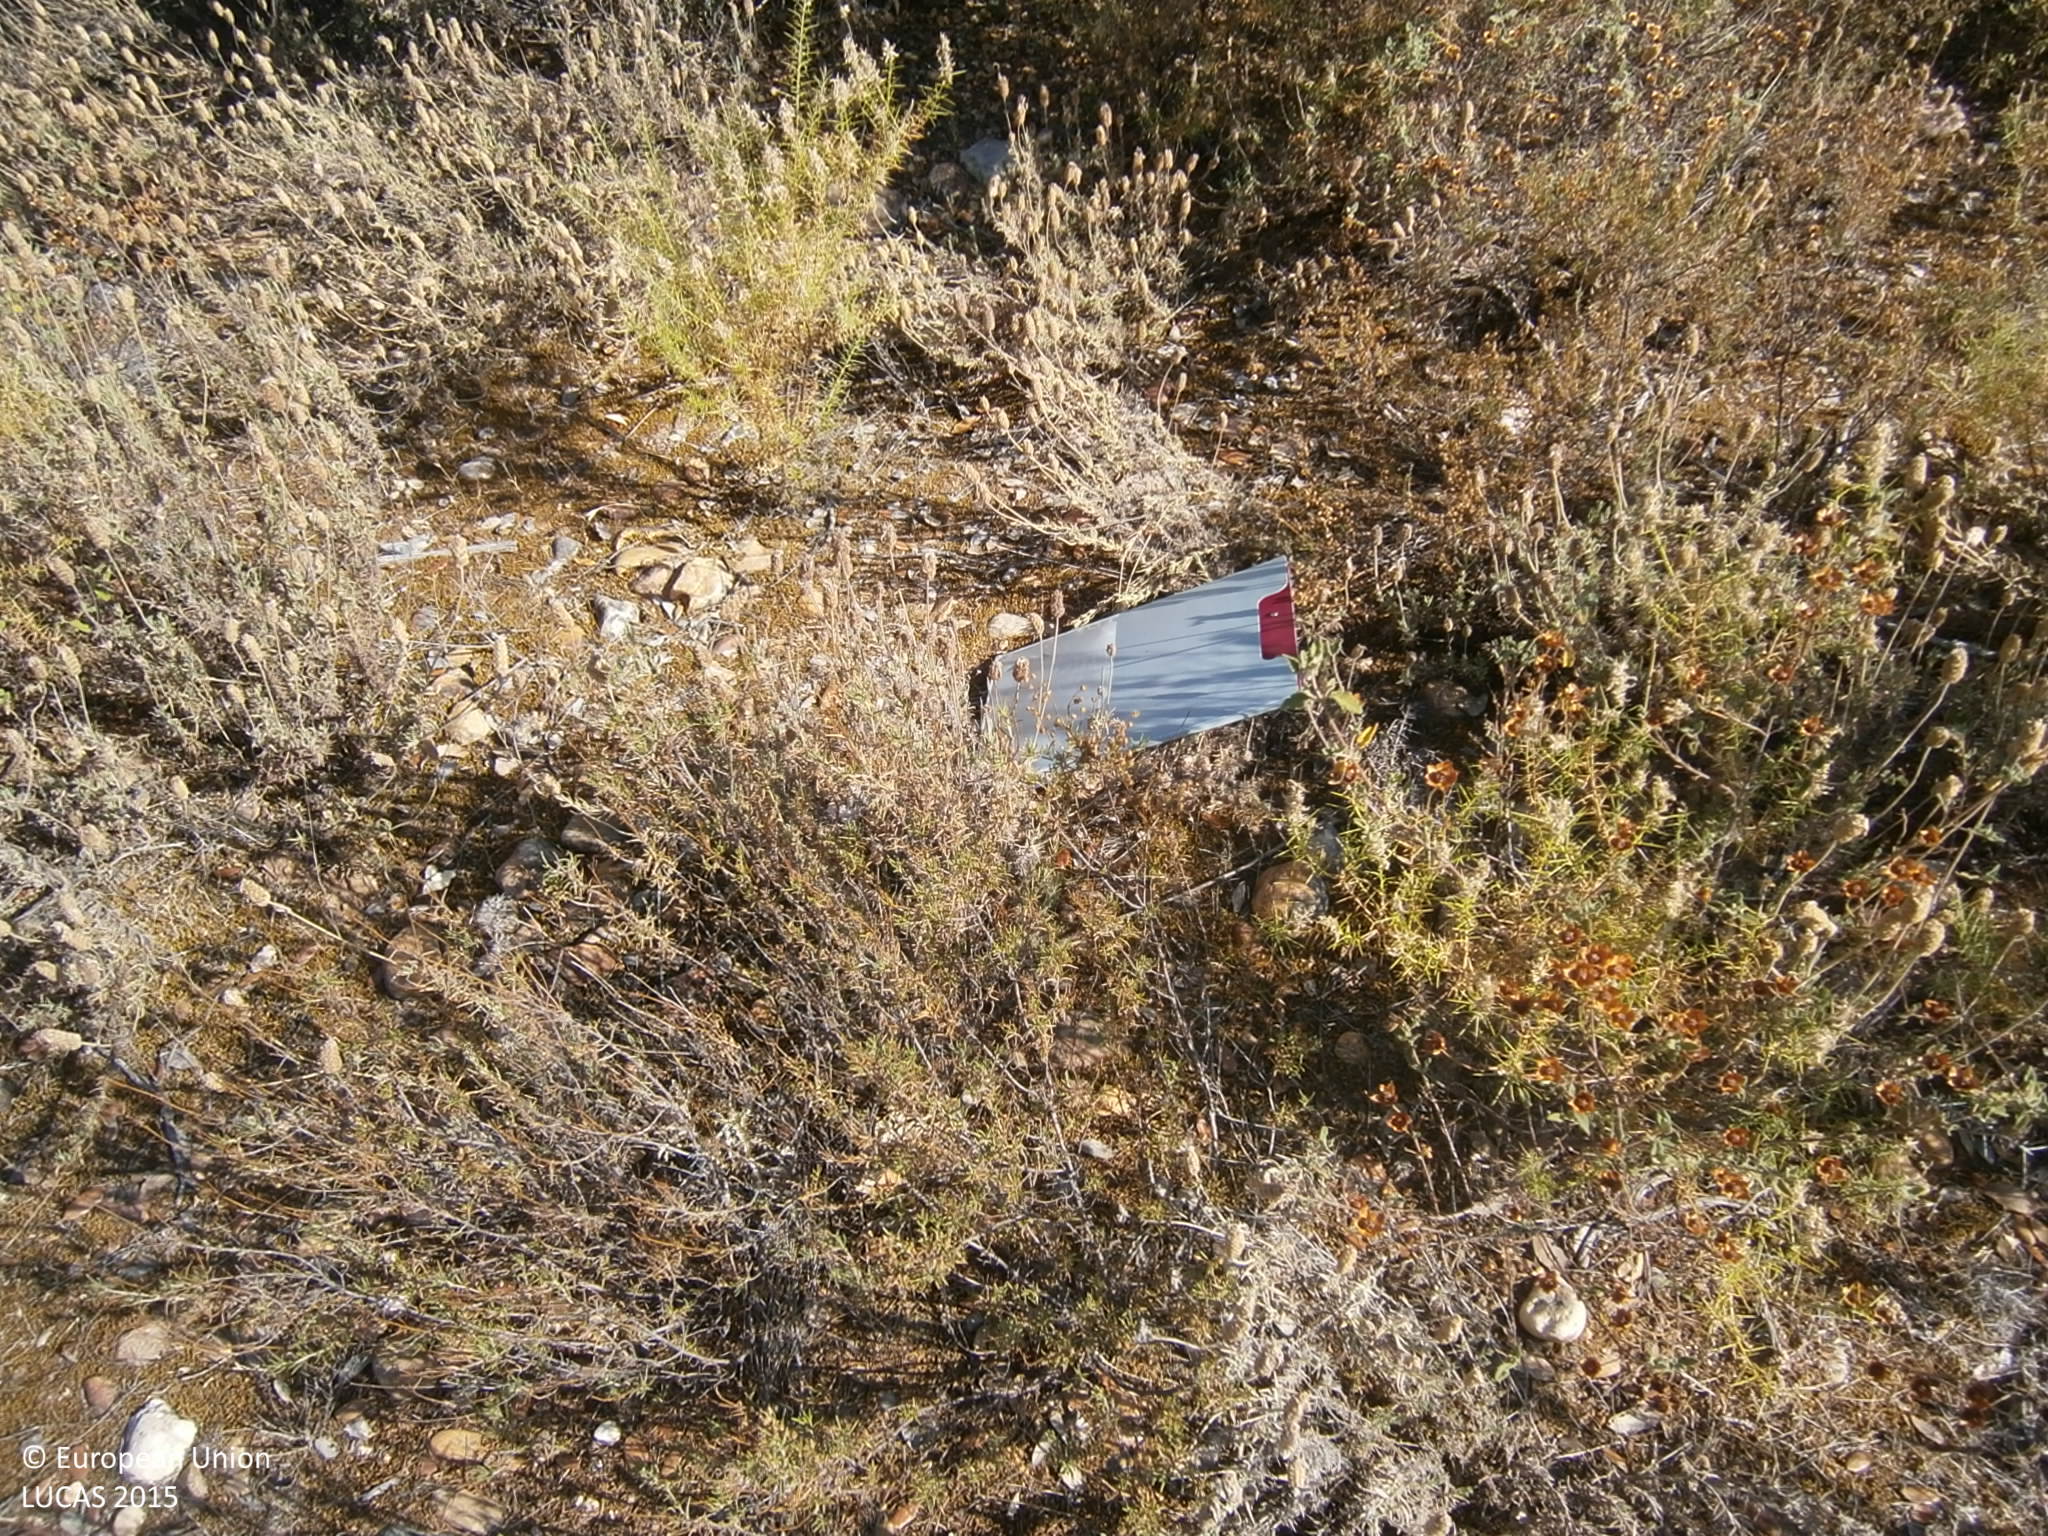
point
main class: Woodland
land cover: Broadleaved woodland
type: broadleaved evergreen forest
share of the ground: > 75 %
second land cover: Spontaneously vegetated surfaces
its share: > 75 %
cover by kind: broadleaved forest trees 90 %, unconsolidated bare surface 5 %
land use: Forestry
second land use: Agriculture (excluding fallow land and kitchen gardens)
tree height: < 5 m
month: June
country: ES
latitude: 38.8444
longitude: -6.9006
